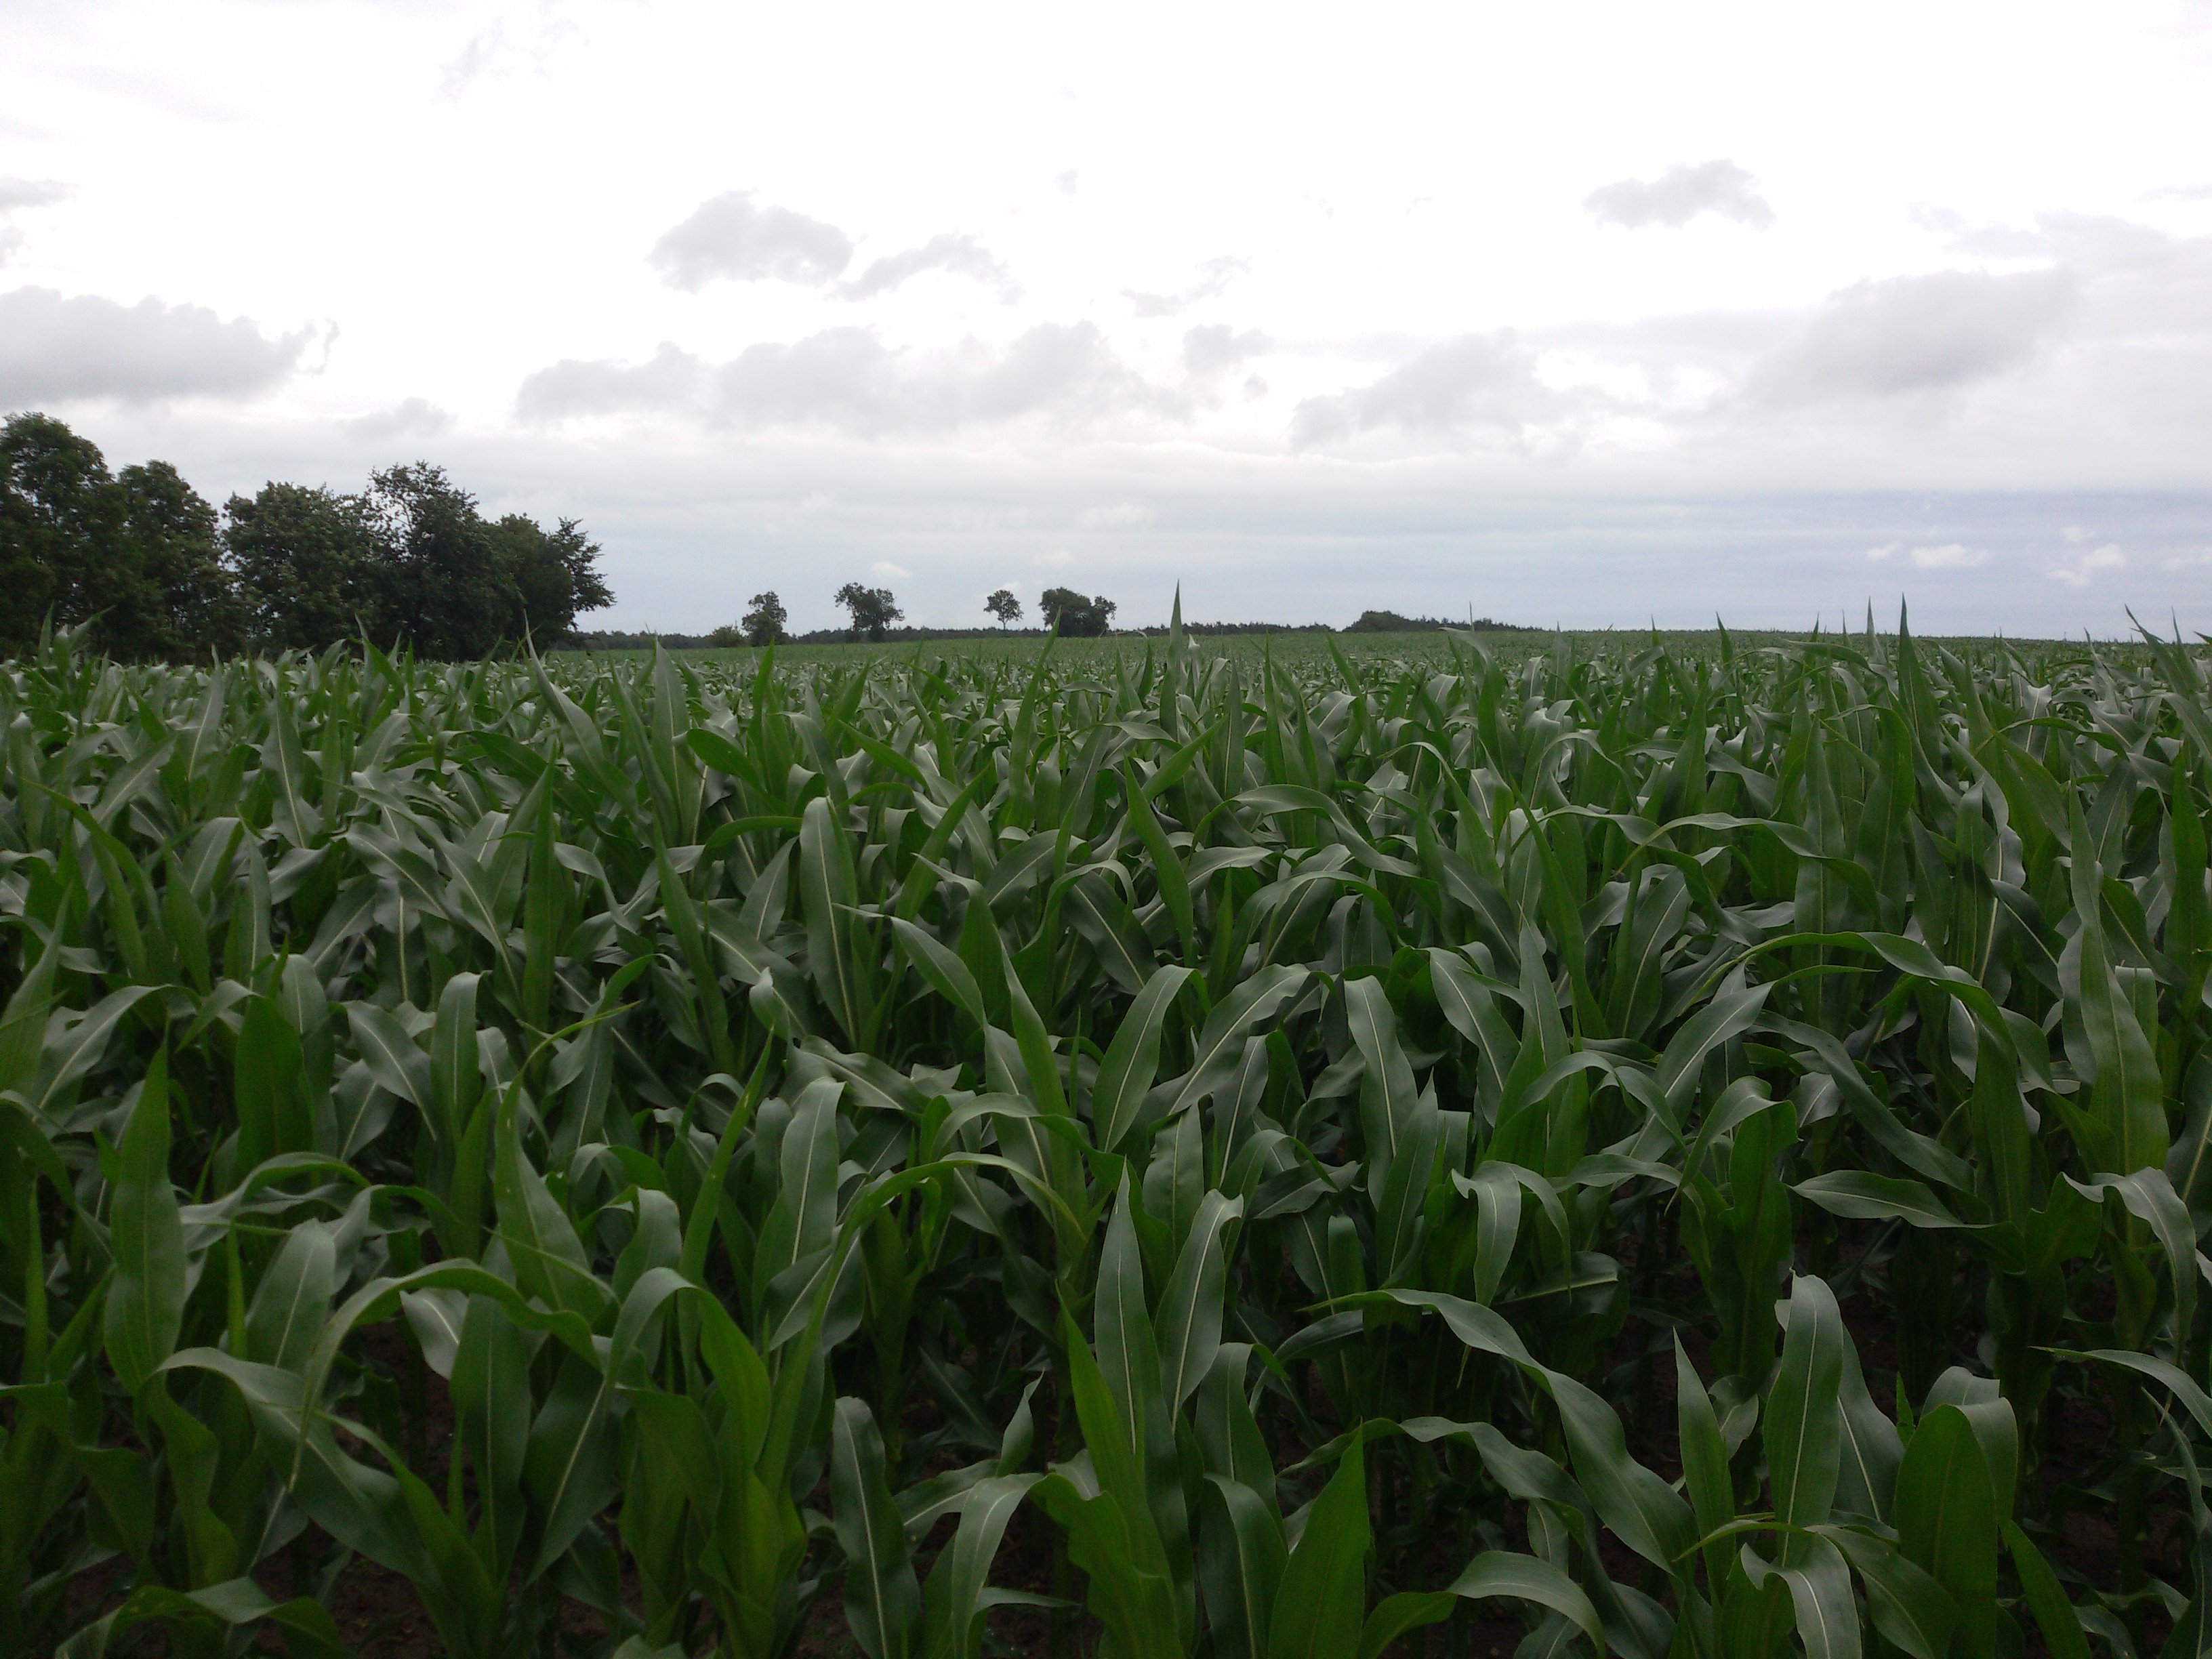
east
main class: Cropland
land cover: Maize
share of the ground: > 75 %
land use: Agriculture (excluding fallow land and kitchen gardens)
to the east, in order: Maize; Grass margins; Tracks; Grass margins; Maize
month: July
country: PL
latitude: 52.8540
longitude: 17.6313
